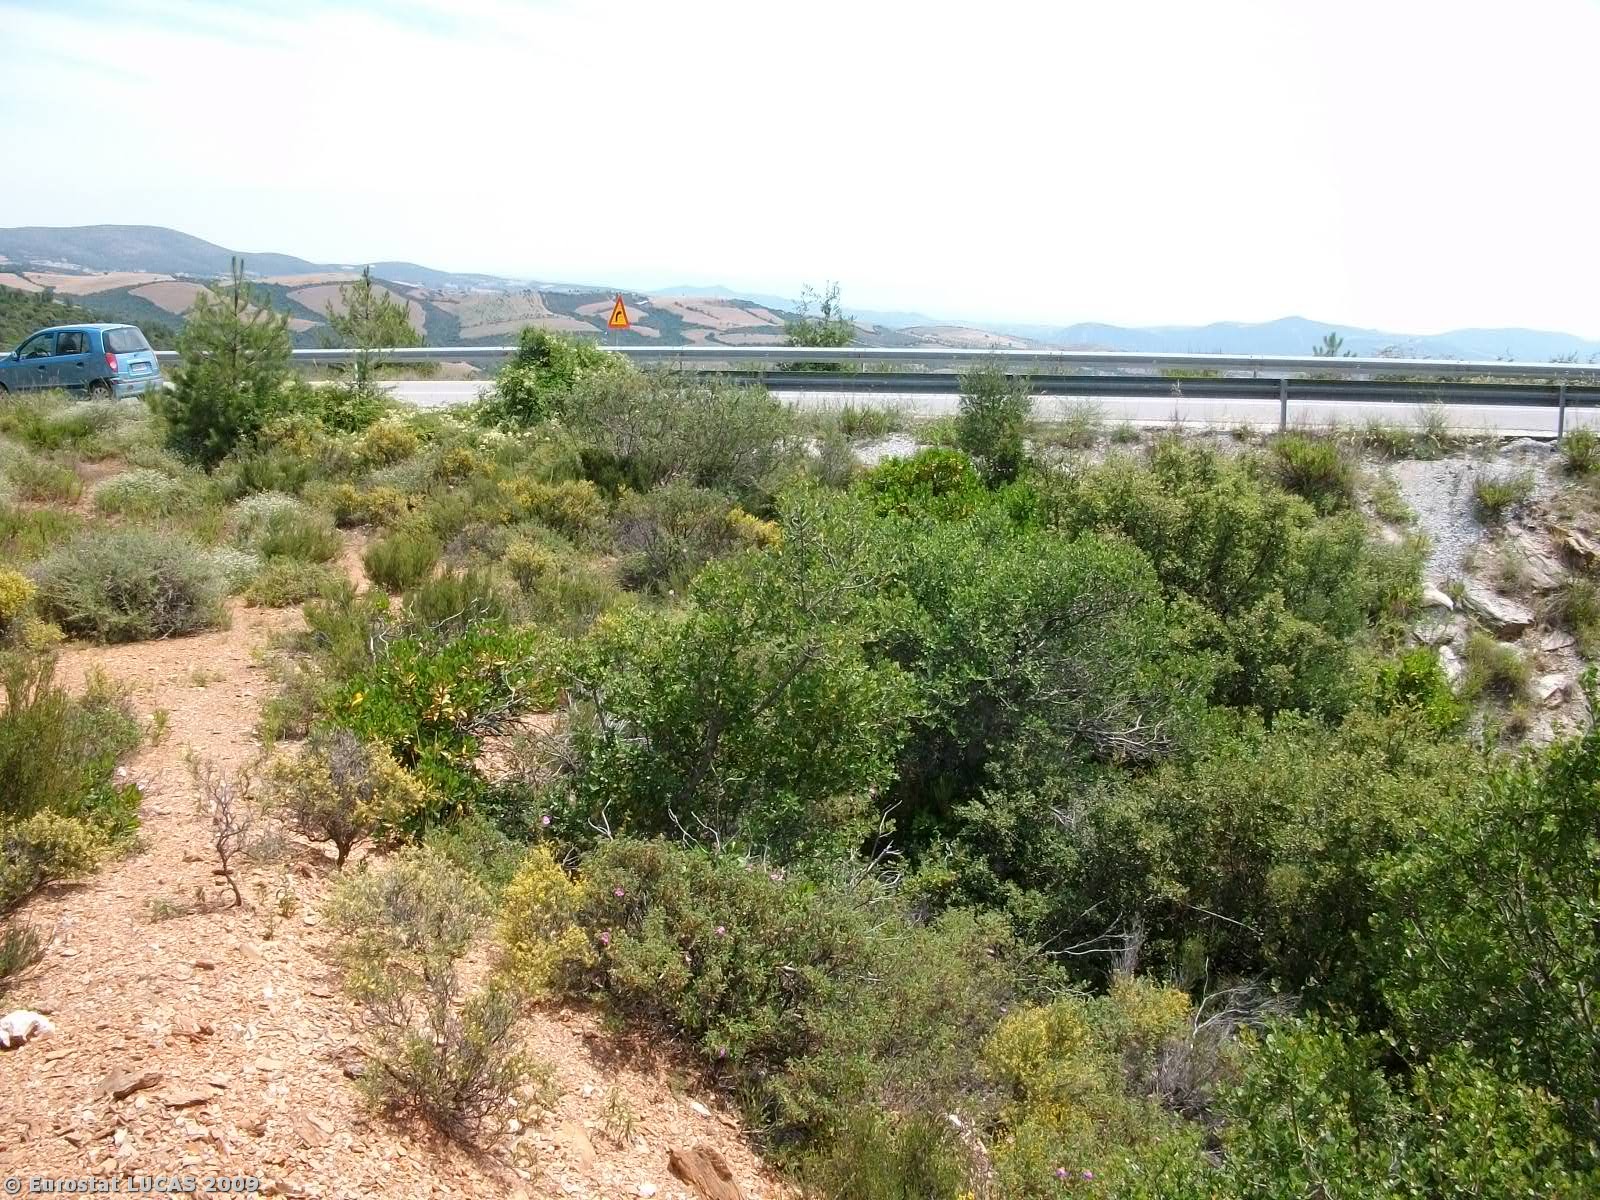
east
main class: Shrubland
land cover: Shrubland with sparse tree cover
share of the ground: > 75 %
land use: Unused
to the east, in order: Shrubland with sparse tree cover; Paved roads, cycling and walking lanes; Shrubland with sparse tree cover; Coniferous woodland
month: June
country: GR
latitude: 40.3561
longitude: 23.4924
